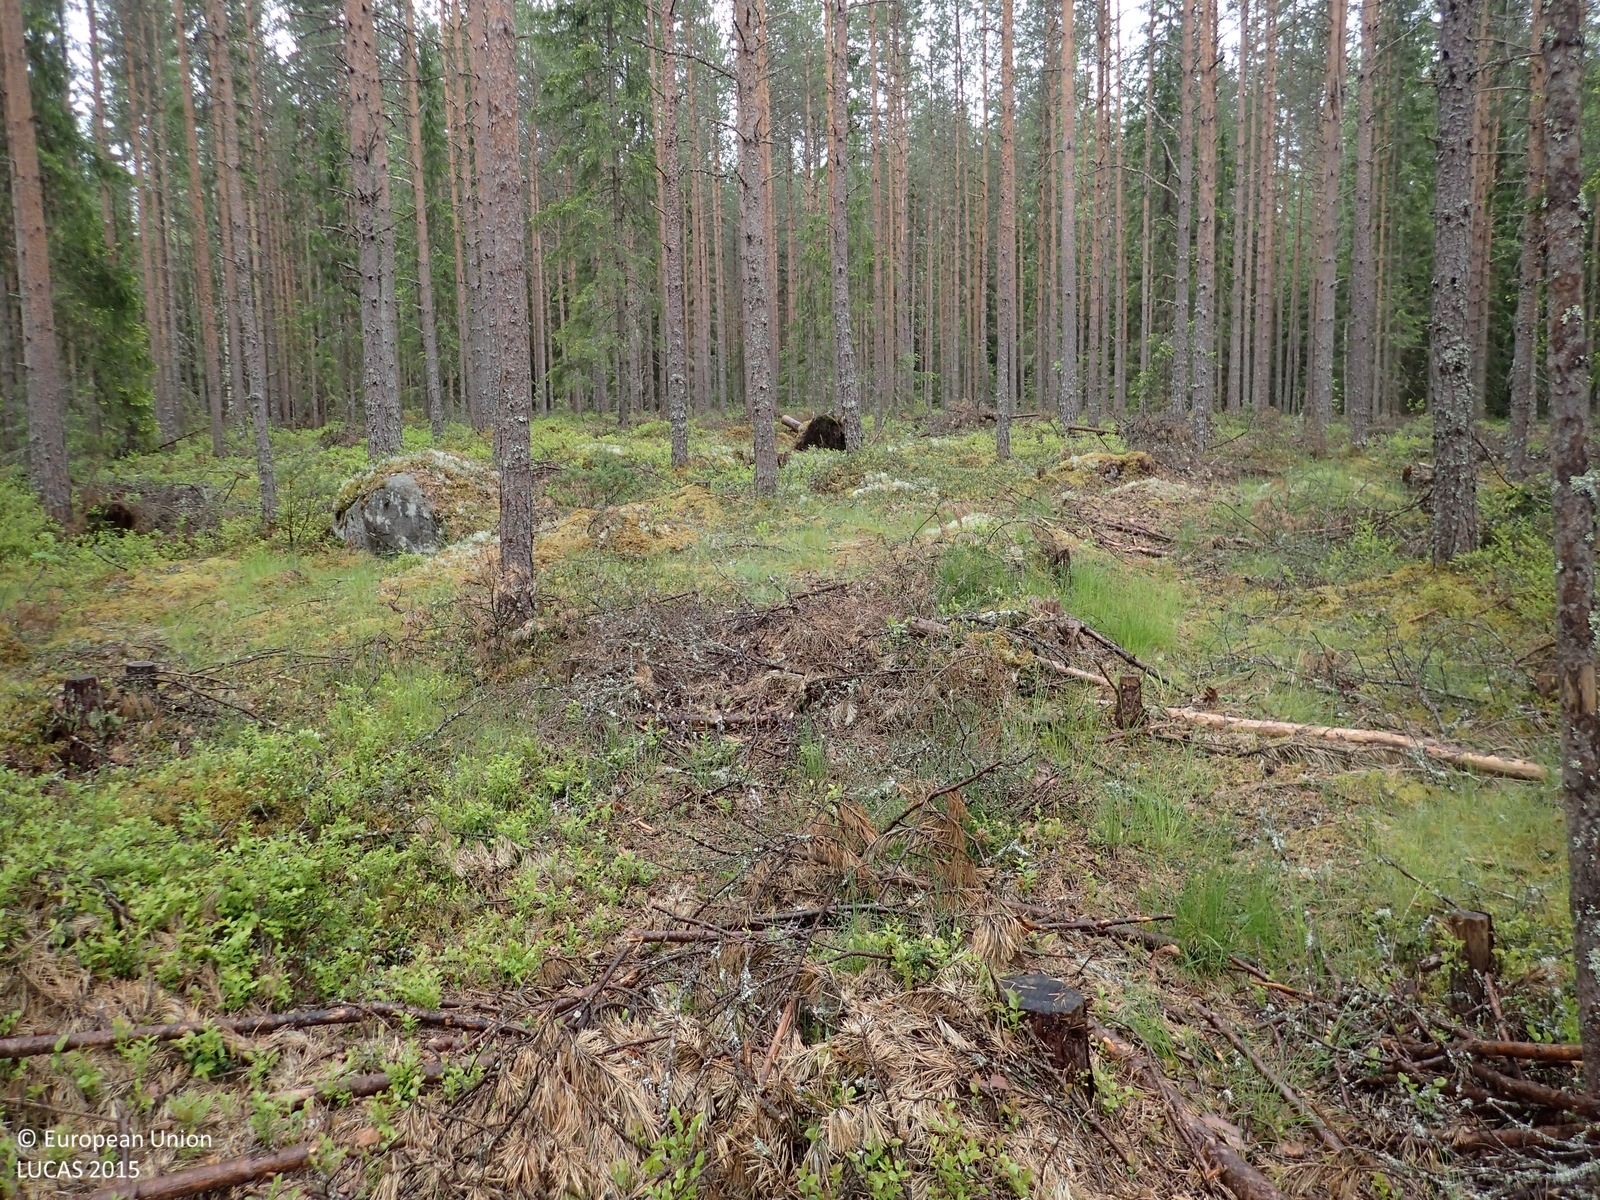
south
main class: Woodland
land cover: Pine dominated coniferous woodland
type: boreal forest
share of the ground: > 75 %
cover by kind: coniferous forest trees 75 %, shrubs 15 %, herbaceous plants 5 %, lichens and mosses 5 %
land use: Forestry
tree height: > 5 m
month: June
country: FI
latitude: 62.2140
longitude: 21.6420
